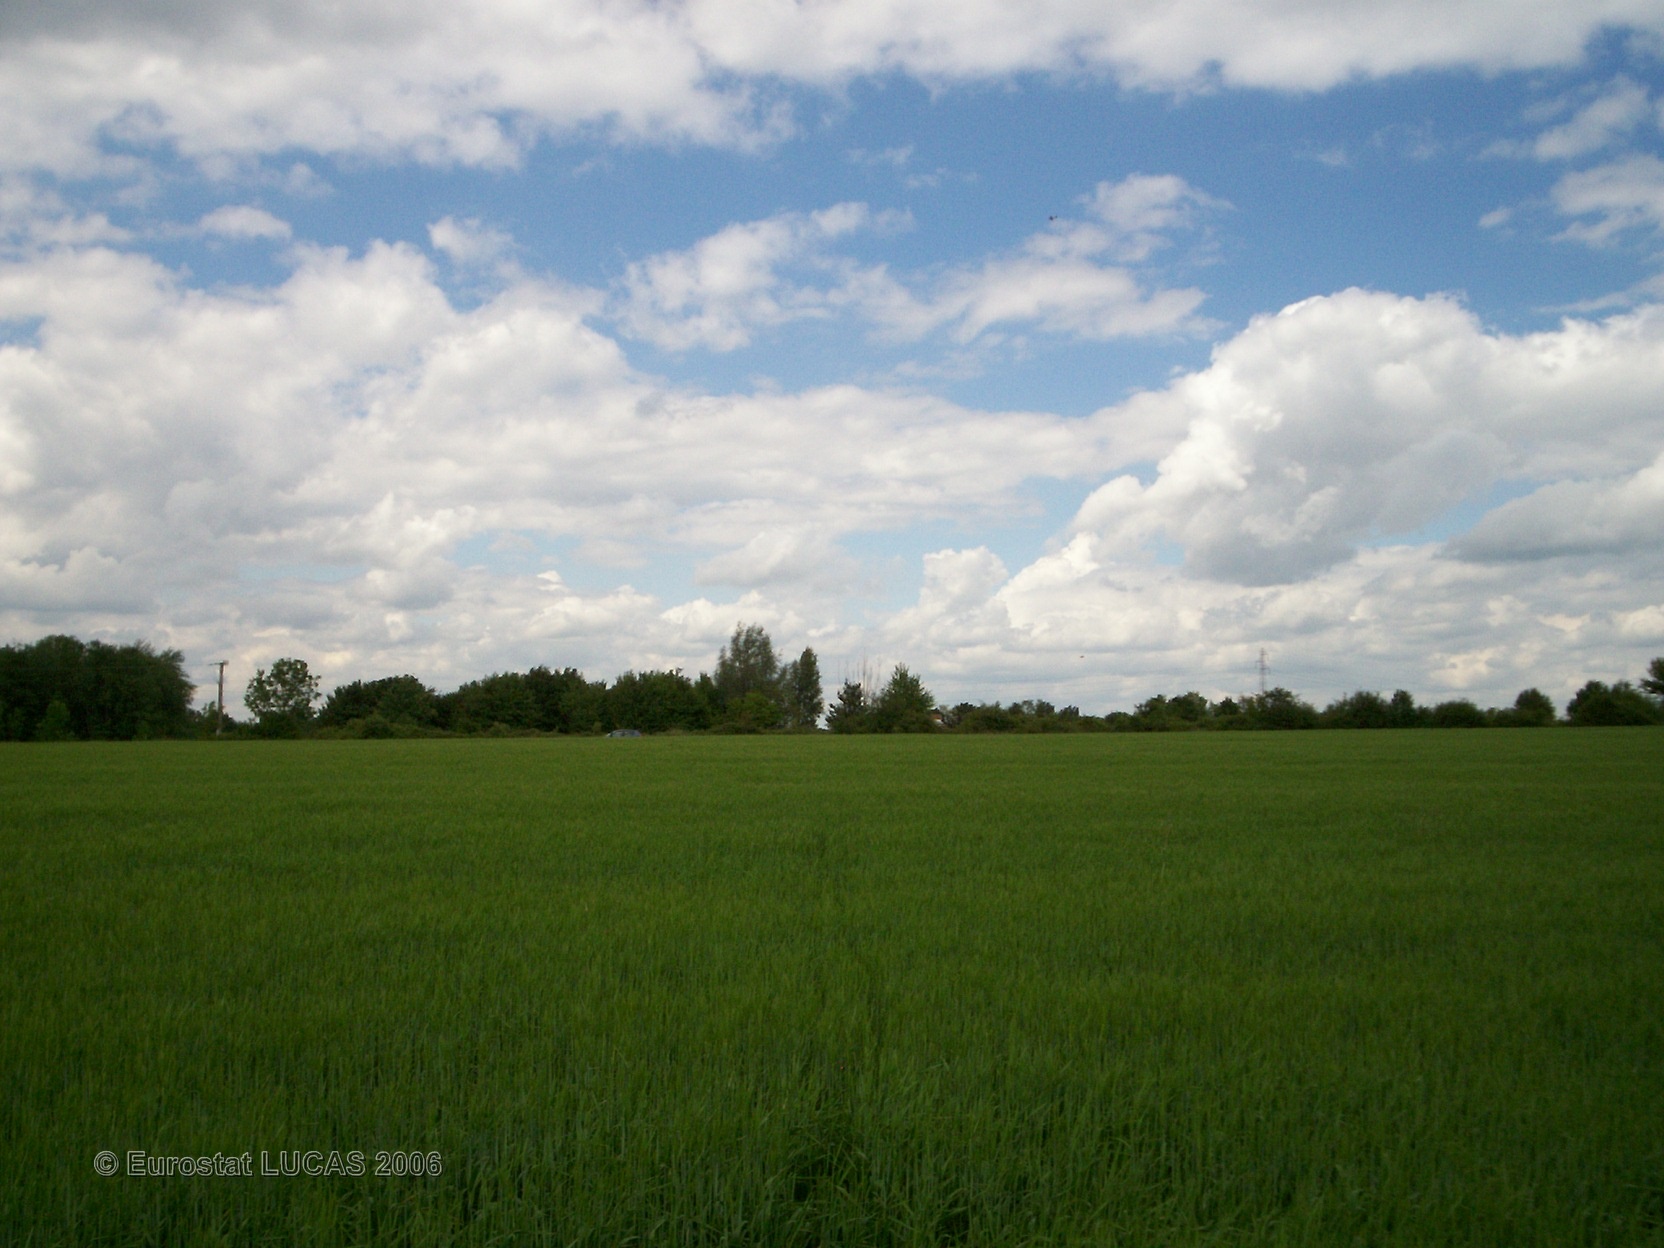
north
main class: Cropland
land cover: Barley
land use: Agriculture (excluding fallow land and kitchen gardens)
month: May
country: FR
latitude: 48.5675
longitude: 2.8220
